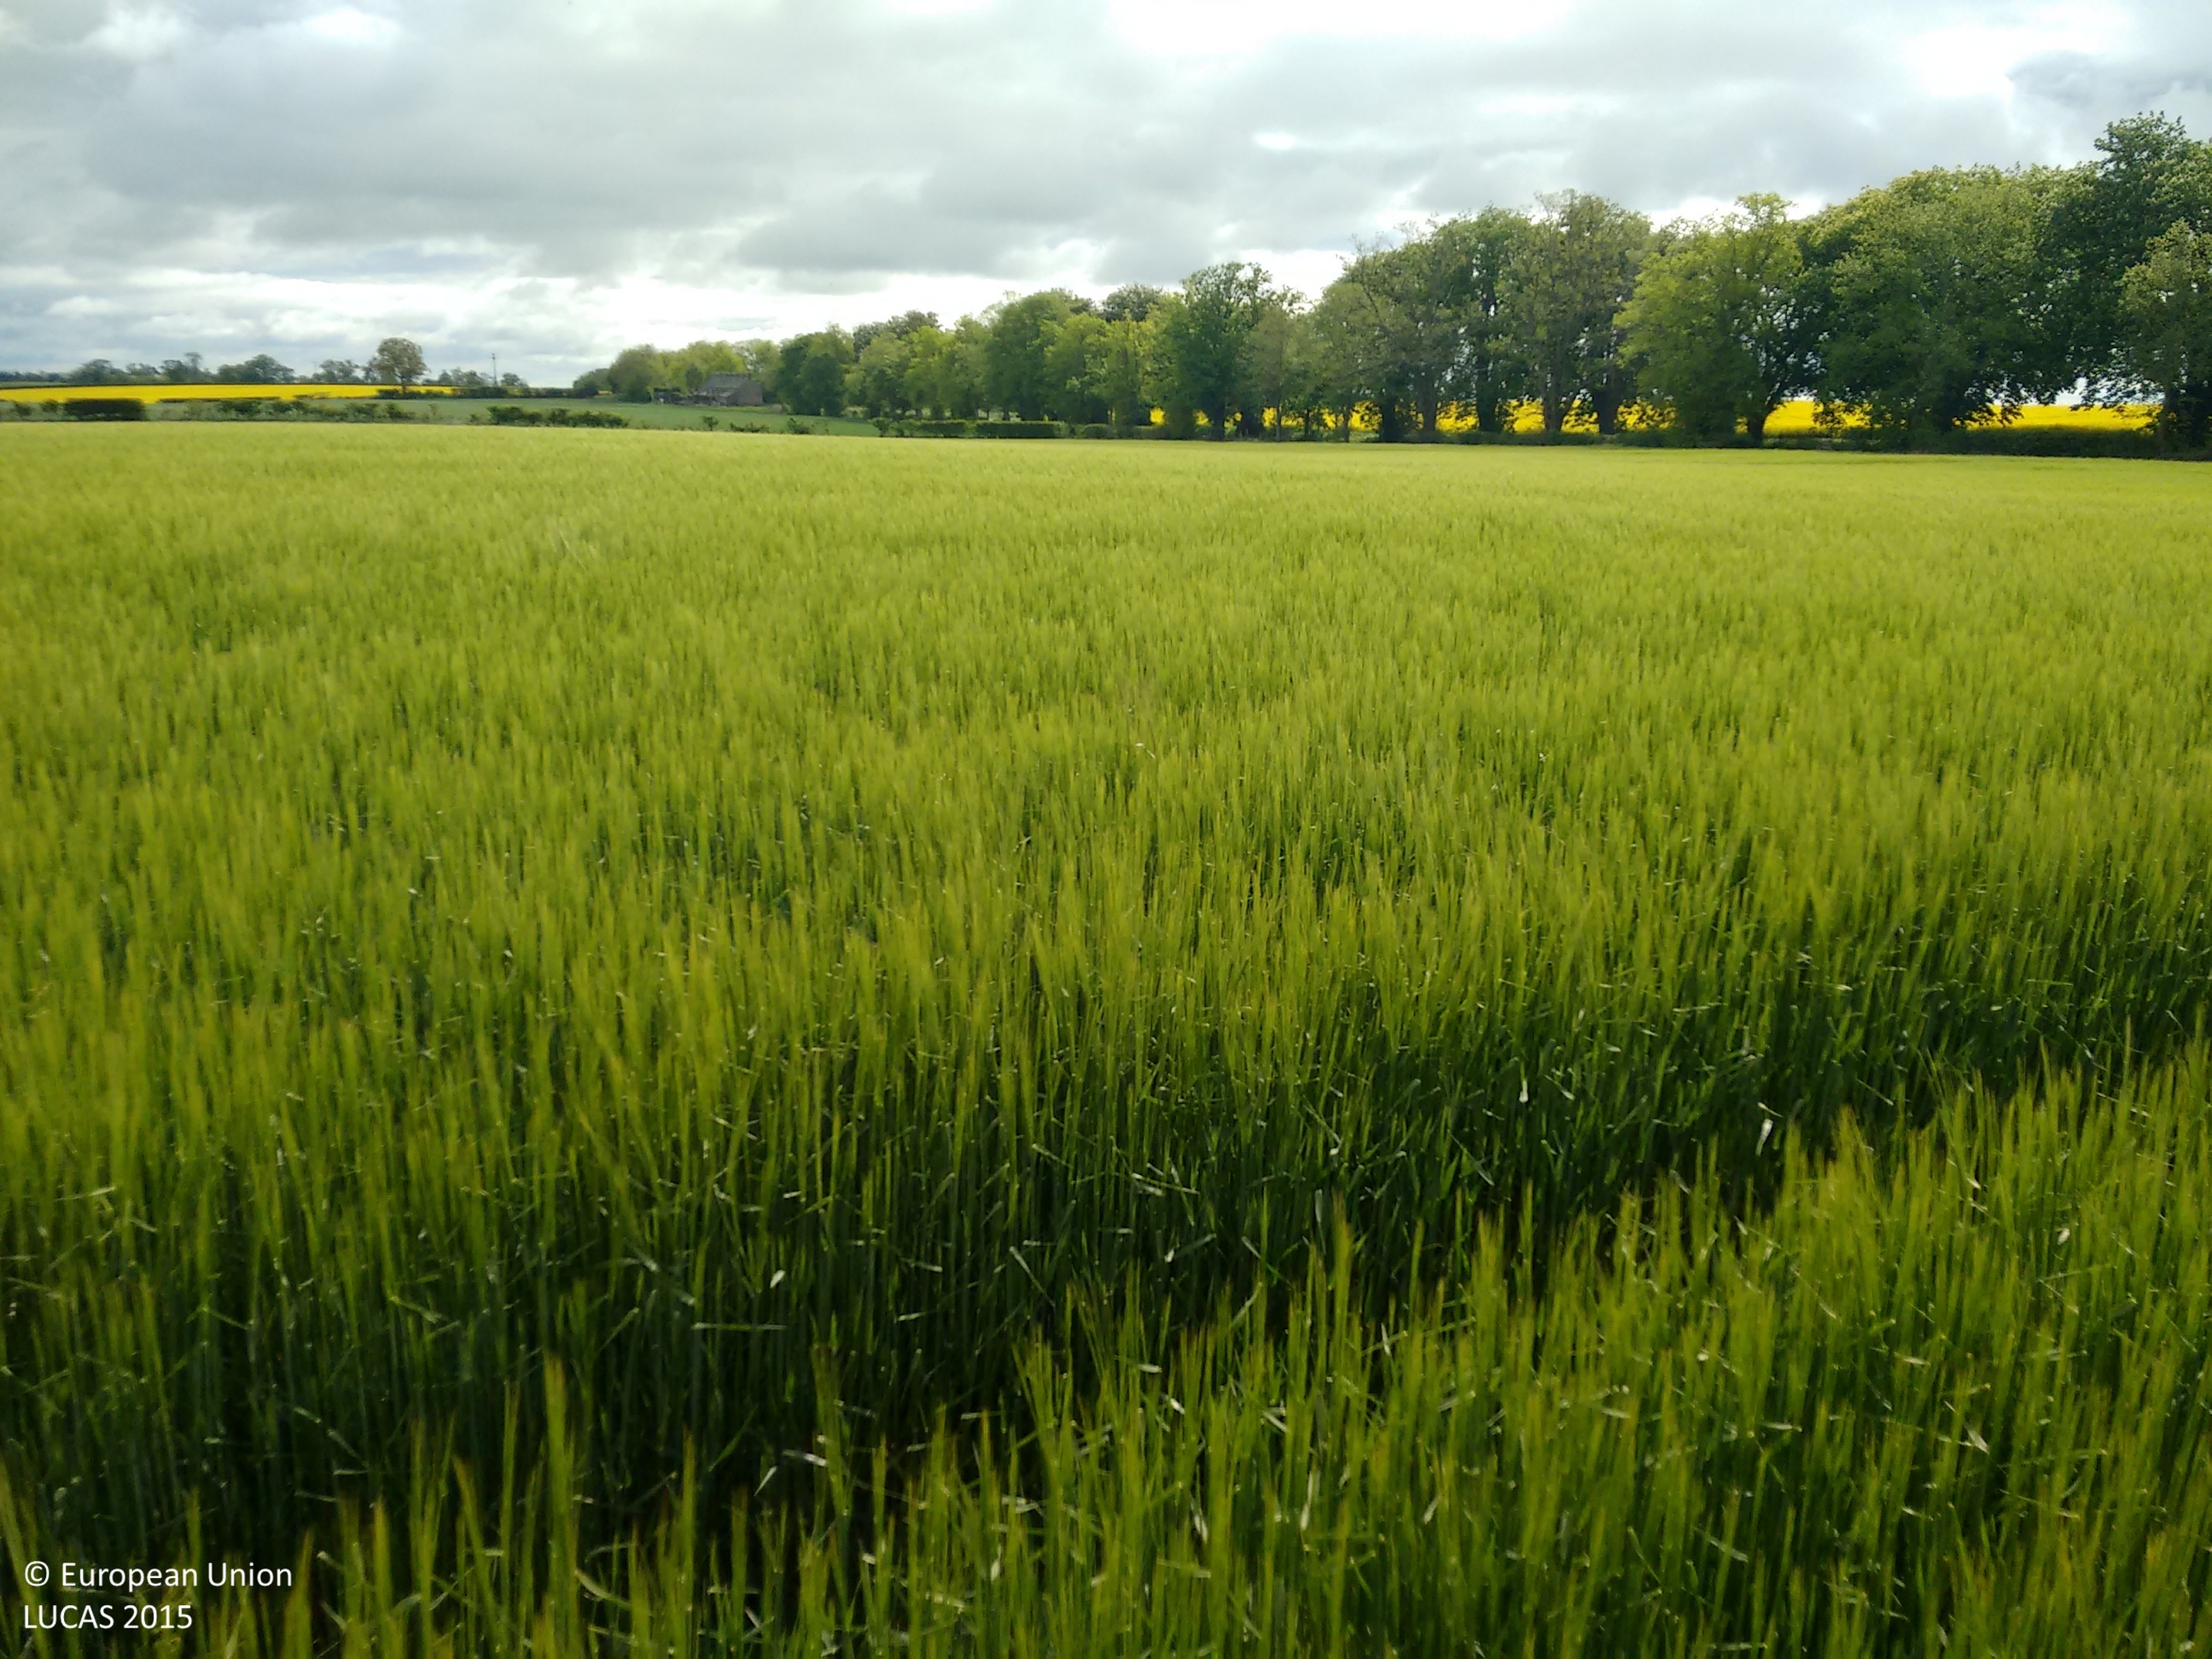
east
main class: Cropland
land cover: Barley
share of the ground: > 75 %
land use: Agriculture (excluding fallow land and kitchen gardens)
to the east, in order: Barley; Other bare soil; Spontaneously vegetated surfaces; Fences; Lines of trees; Abandoned hedges; Grass margins; Paved roads, cycling and walking lanes
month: May
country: GB
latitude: 55.6915
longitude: -2.2256
